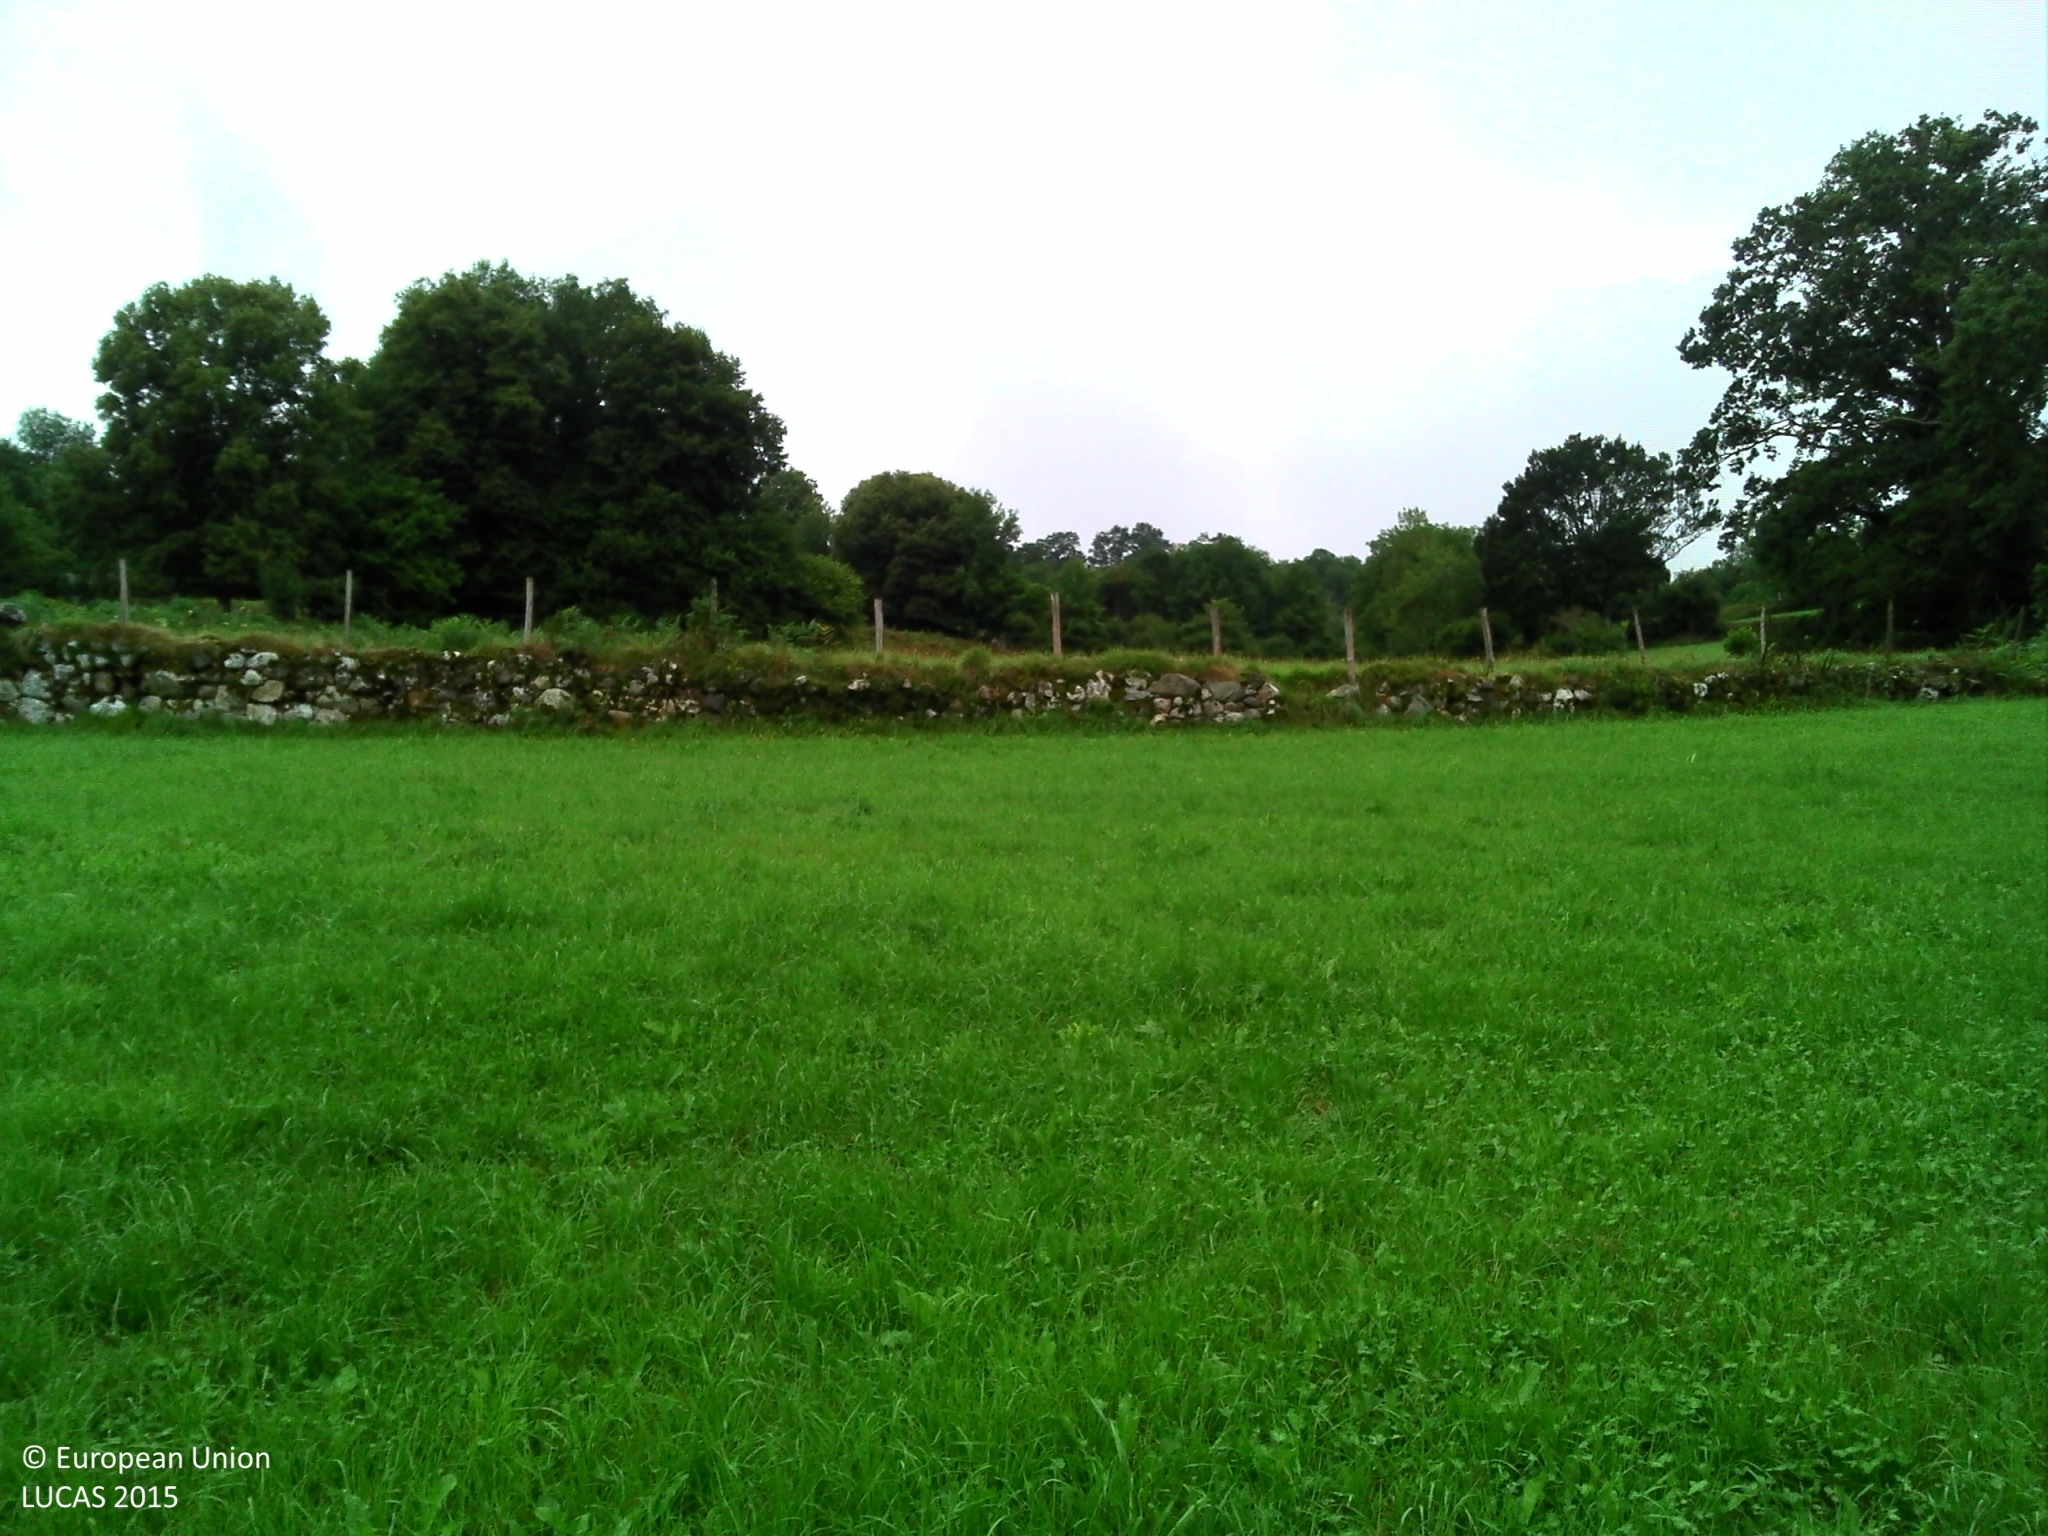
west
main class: Grassland
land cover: Grassland without tree/shrub cover
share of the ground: > 75 %
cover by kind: herbaceous plants 100 %
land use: Agriculture (excluding fallow land and kitchen gardens)
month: July
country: FR
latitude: 43.1007
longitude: -0.3879
